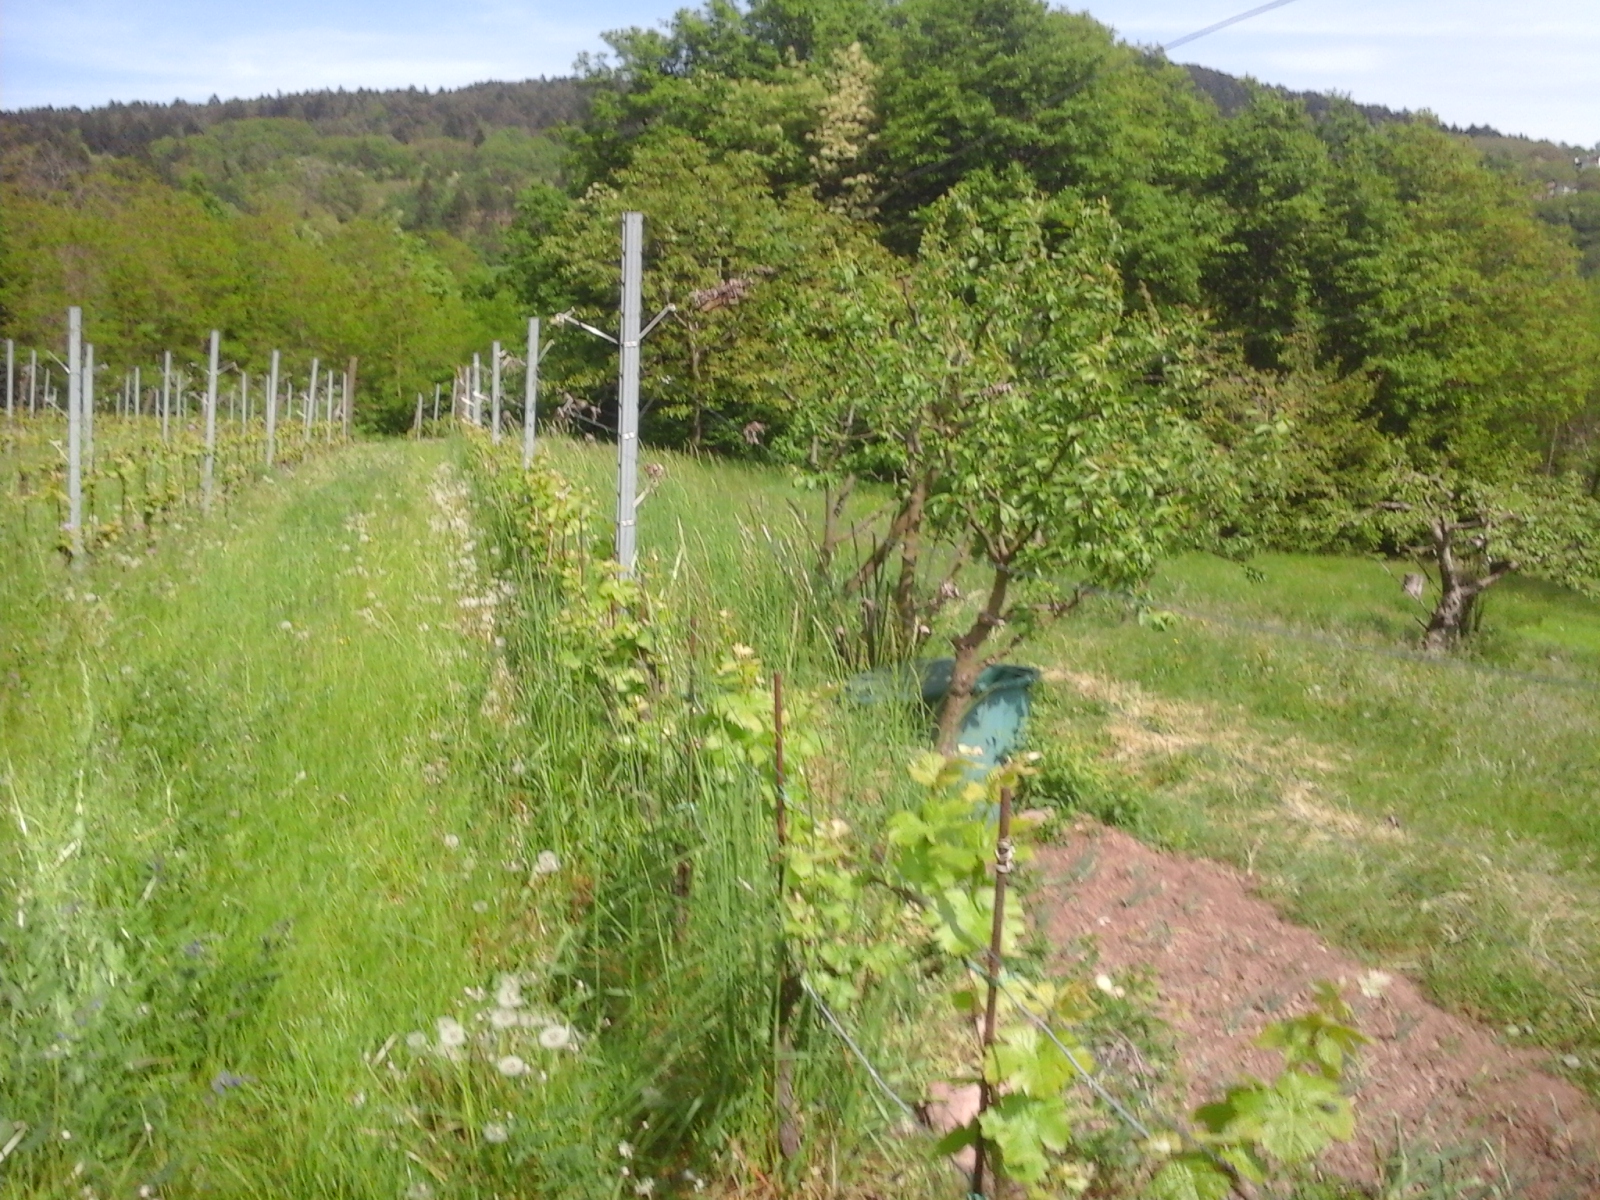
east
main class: Cropland
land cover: Vineyards
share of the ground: < 10 %
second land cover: Grassland without tree/shrub cover
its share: > 75 %
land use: Agriculture (excluding fallow land and kitchen gardens)
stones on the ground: < 10 %
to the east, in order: Vineyards; Grassland without tree/shrub cover; Grass margins; Apple fruit; Broadleaved woodland; Tracks; Broadleaved woodland; Other coniferous woodland; Broadleaved woodland; Rivers and streams; Grassland without tree/shrub cover; Broadleaved woodland; Other mixed woodland; Grassland without tree/shrub cover
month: May
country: IT
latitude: 46.1105
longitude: 11.1757
